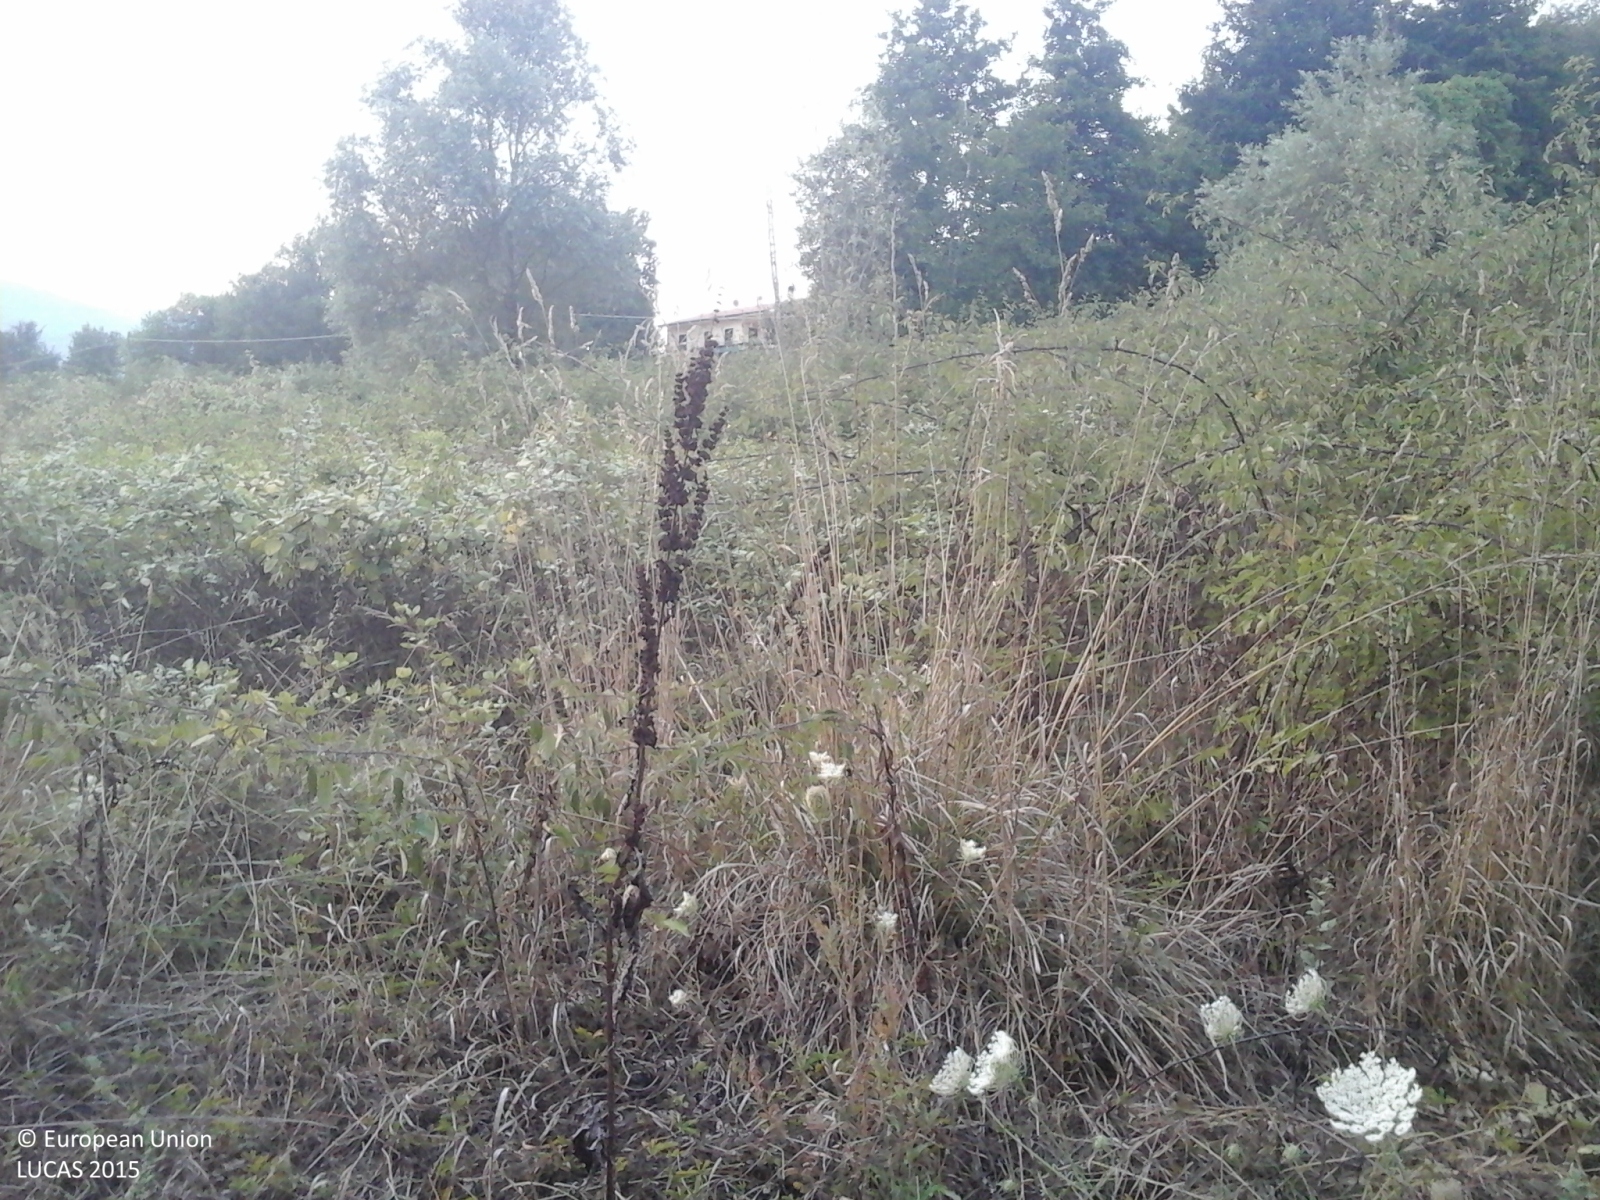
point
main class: Woodland
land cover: Broadleaved woodland
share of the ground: > 75 %
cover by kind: broadleaved forest trees 100 %
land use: Forestry
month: August
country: IT
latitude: 43.8794
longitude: 10.6579
